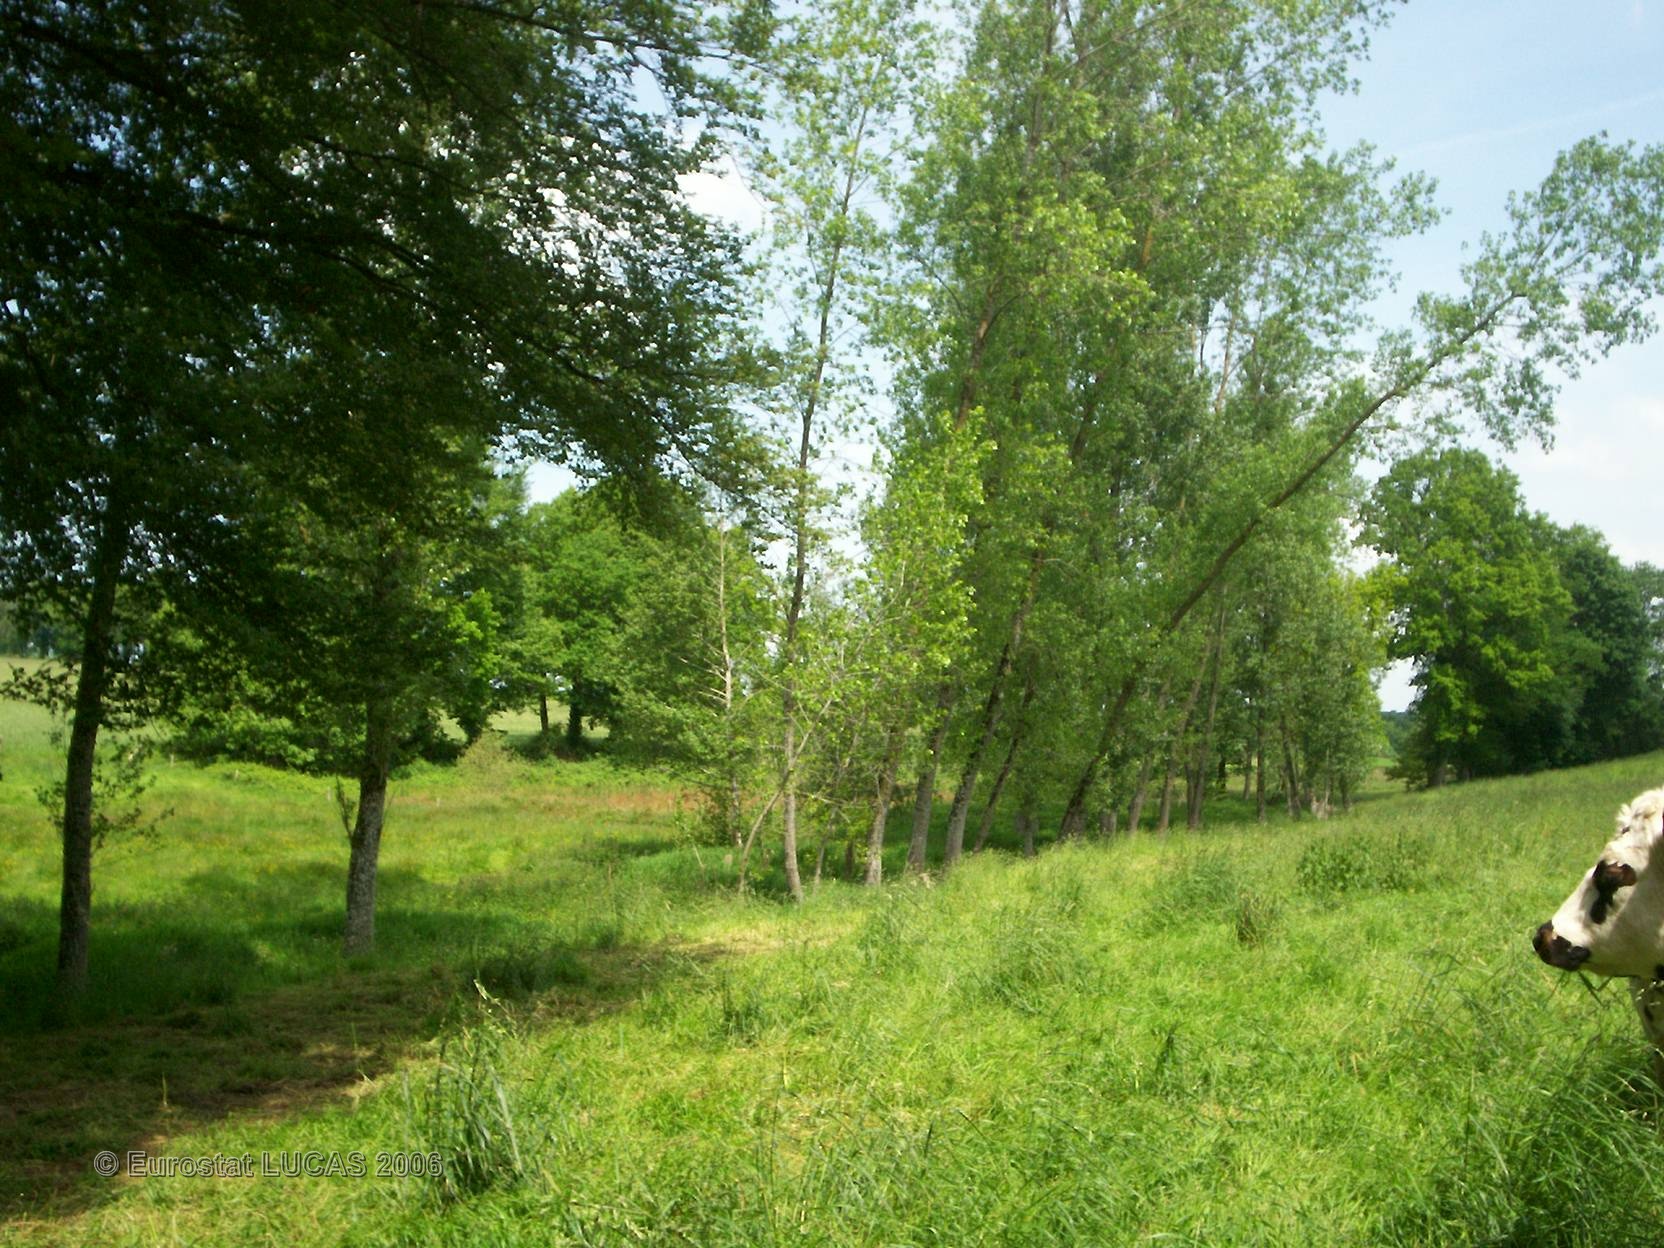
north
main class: Grassland
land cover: Grassland without tree/shrub cover
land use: Agriculture (excluding fallow land and kitchen gardens)
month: June
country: FR
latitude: 48.4654
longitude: -1.2281
